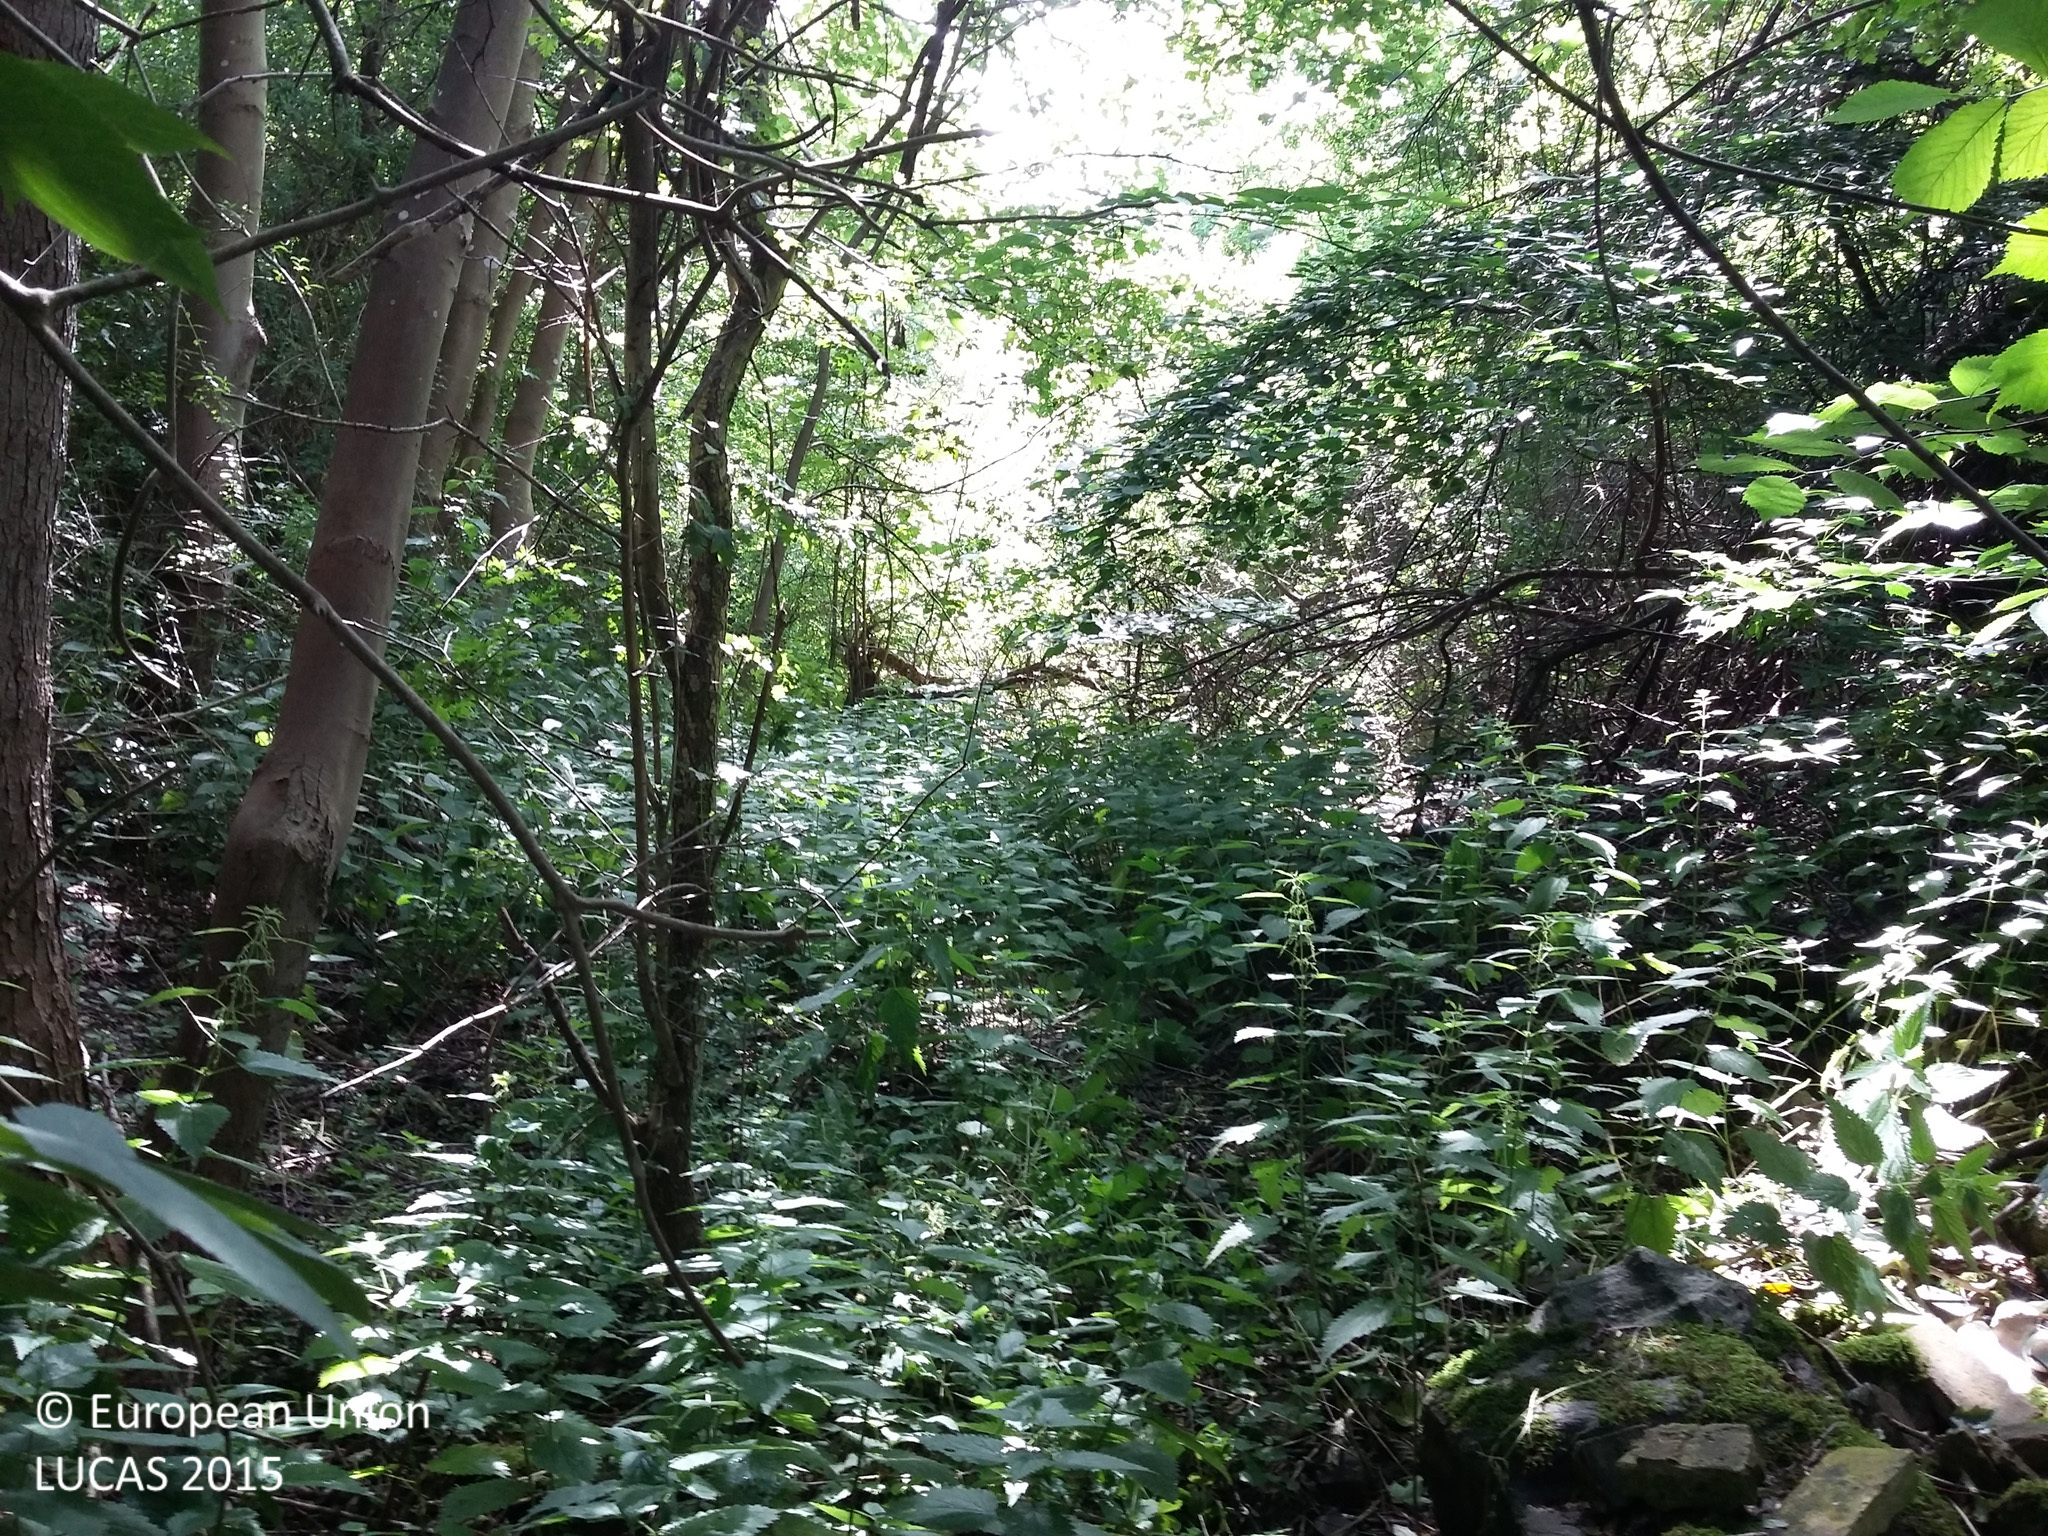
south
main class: Woodland
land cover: Broadleaved woodland
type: beech forest
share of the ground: > 75 %
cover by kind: broadleaved forest trees 80 %, herbaceous plants 15 %, shrubs 5 %
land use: Semi-natural and natural areas not in use
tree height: > 5 m
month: July
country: DK
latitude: 55.4954
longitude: 11.5341
